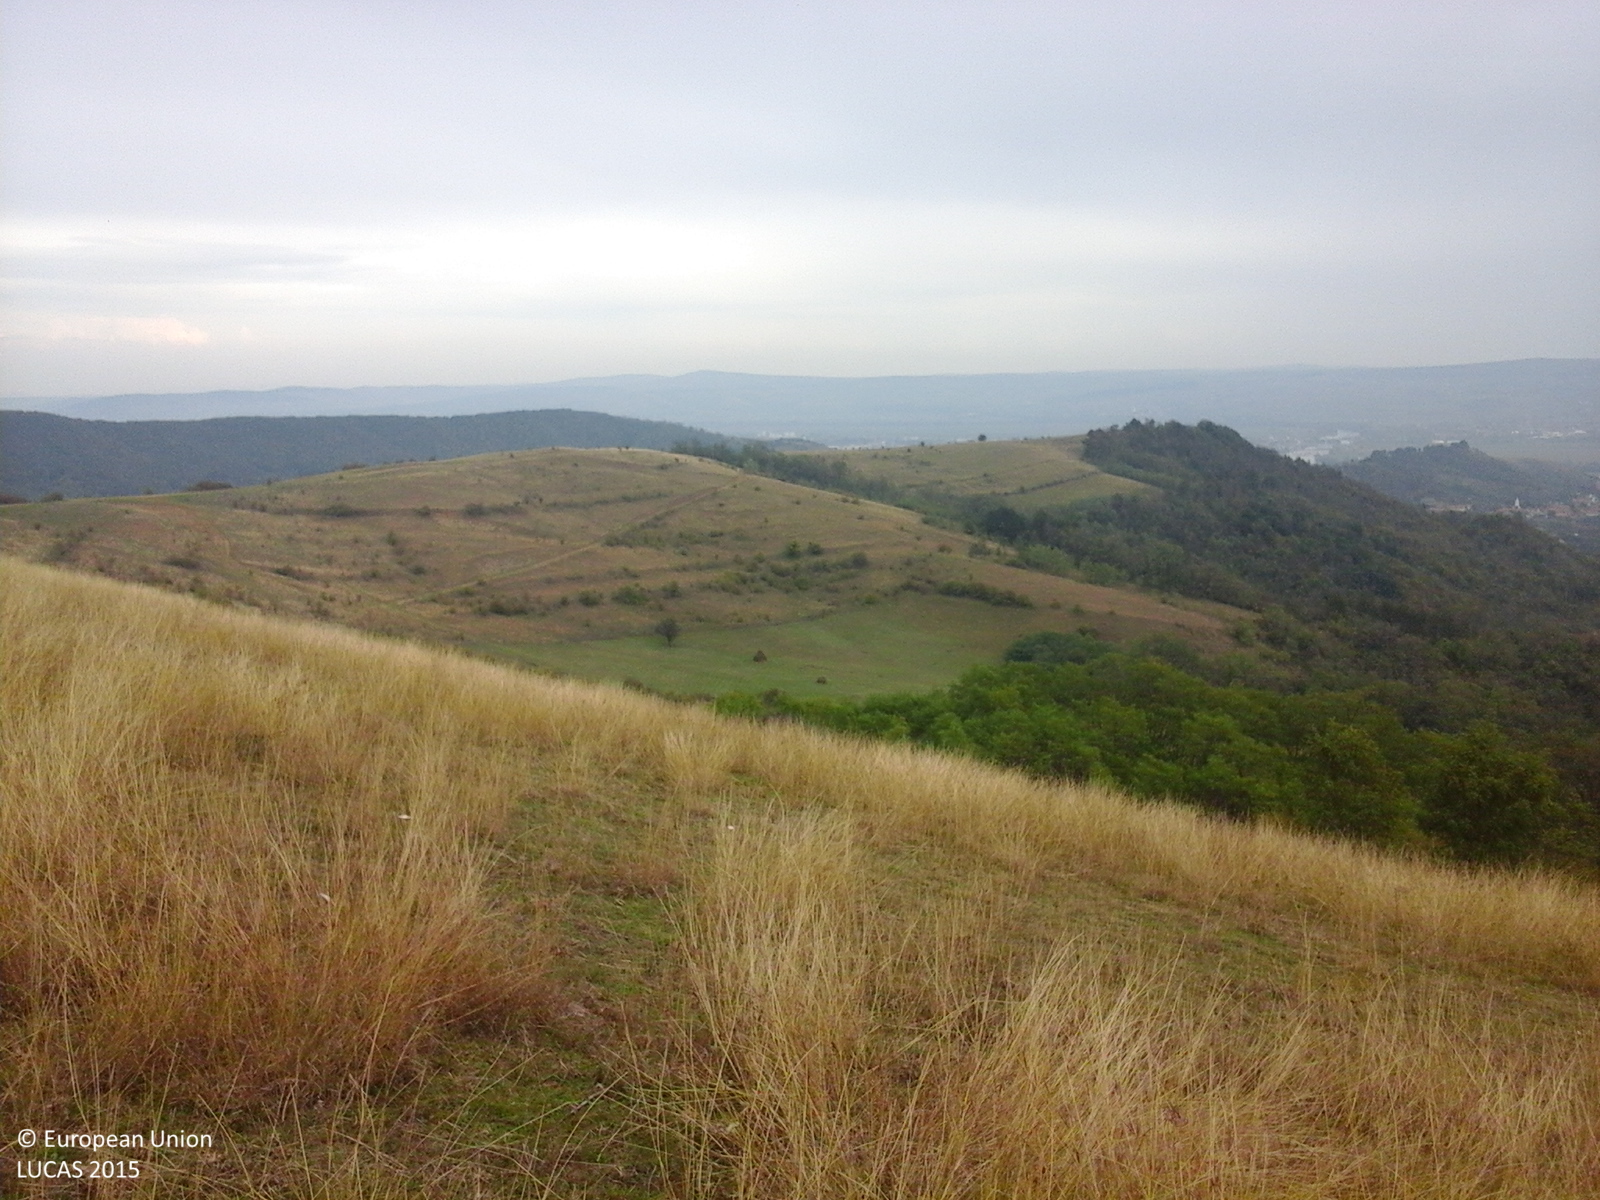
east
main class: Grassland
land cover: Grassland without tree/shrub cover
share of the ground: > 75 %
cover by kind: herbaceous plants 100 %
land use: Agriculture (excluding fallow land and kitchen gardens)
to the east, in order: Grassland without tree/shrub cover; Grassland with sparse tree/shrub cover
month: October
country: RO
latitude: 46.0572
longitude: 23.4946
